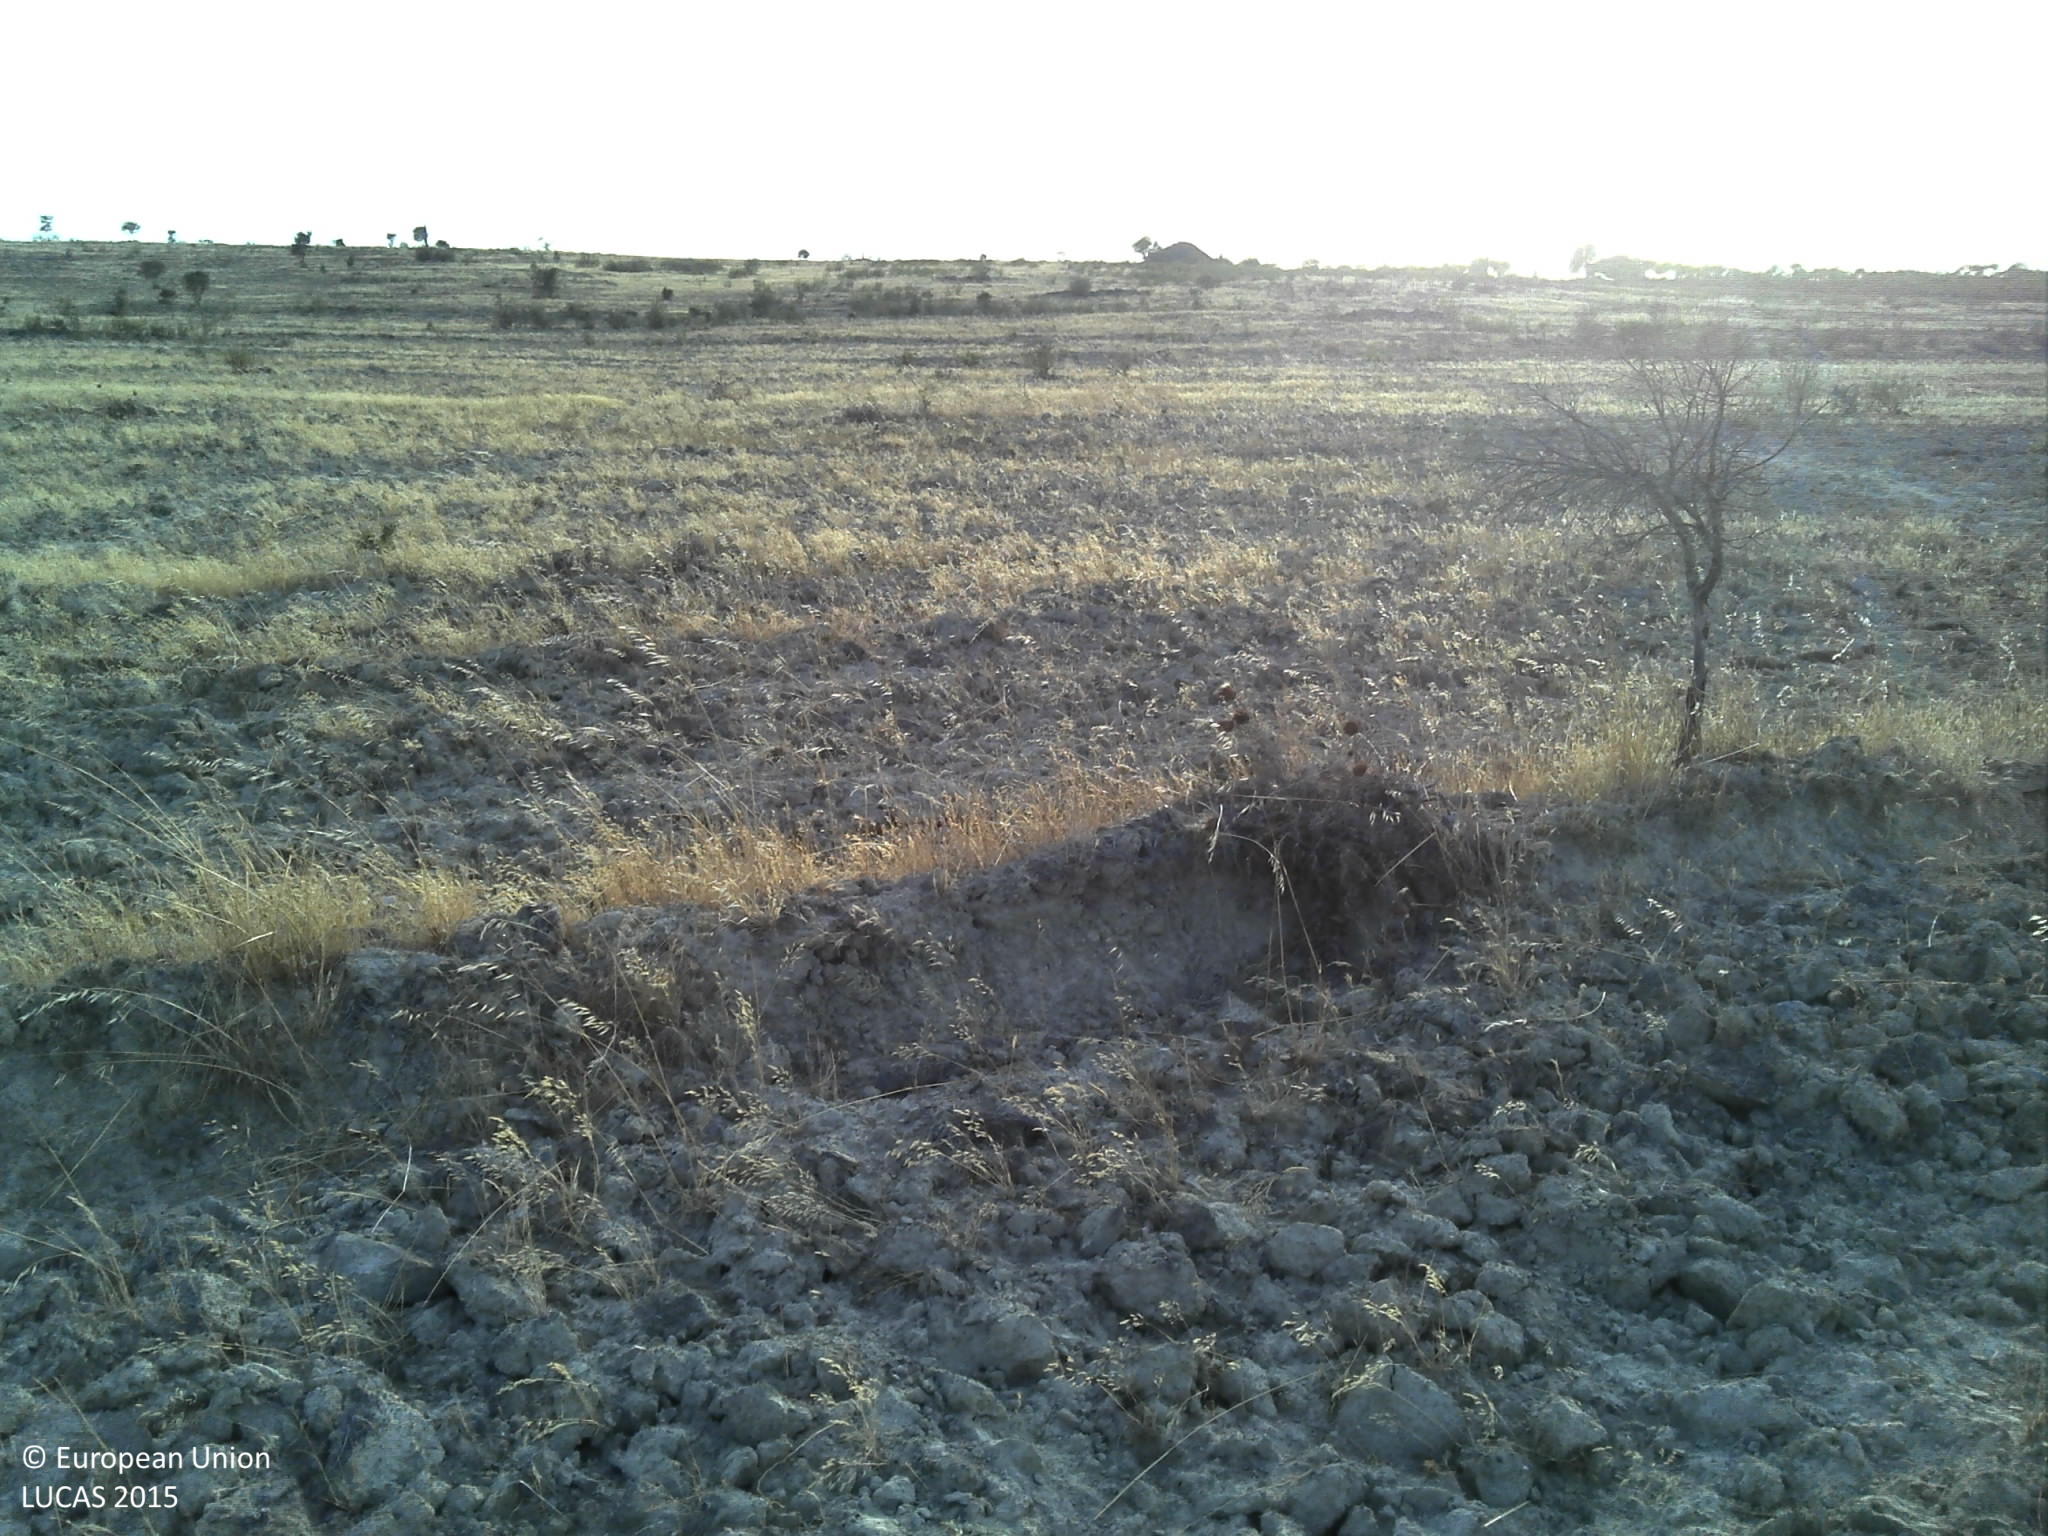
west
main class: Grassland
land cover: Grassland with sparse tree/shrub cover
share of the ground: 50 - 75 %
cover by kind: unconsolidated bare surface 80 %, herbaceous plants 15 %, broadleaved forest trees 5 %
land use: Forestry
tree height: < 5 m
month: July
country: PT
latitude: 37.5491
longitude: -7.9147
